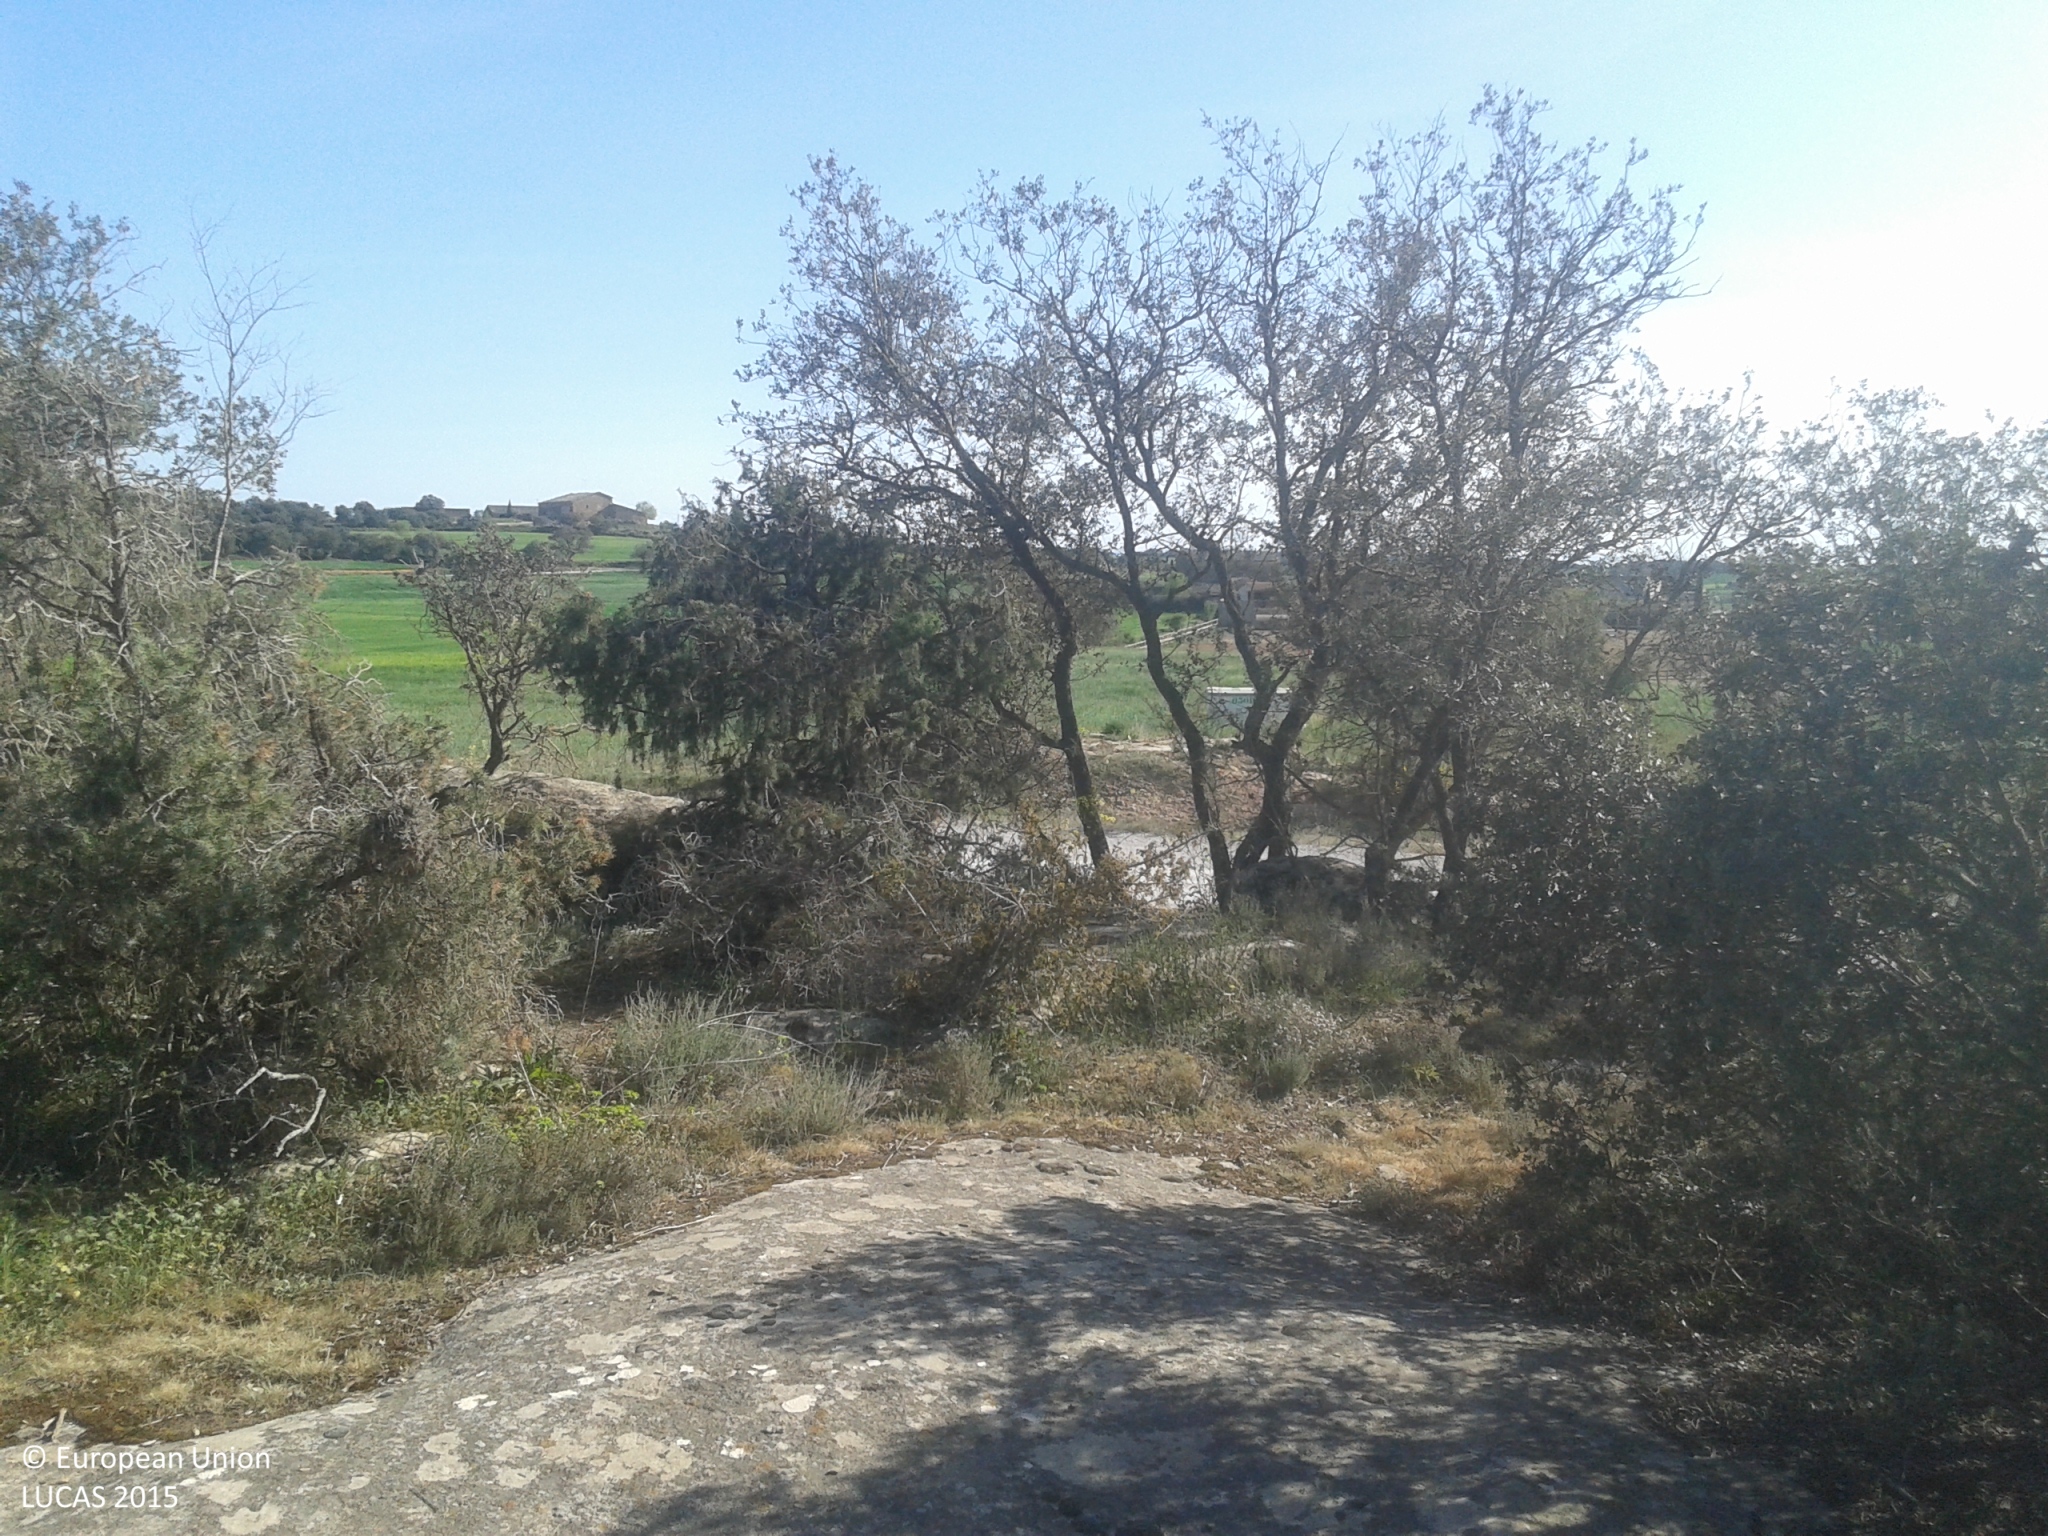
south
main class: Woodland
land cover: Broadleaved woodland
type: broadleaved evergreen forest
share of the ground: 25 - 50 %
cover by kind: broadleaved forest trees 40 %, lichens and mosses 30 %, shrubs 20 %, herbaceous plants 10 %
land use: Semi-natural and natural areas not in use
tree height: > 5 m
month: April
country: ES
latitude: 41.7953
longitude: 1.1674
